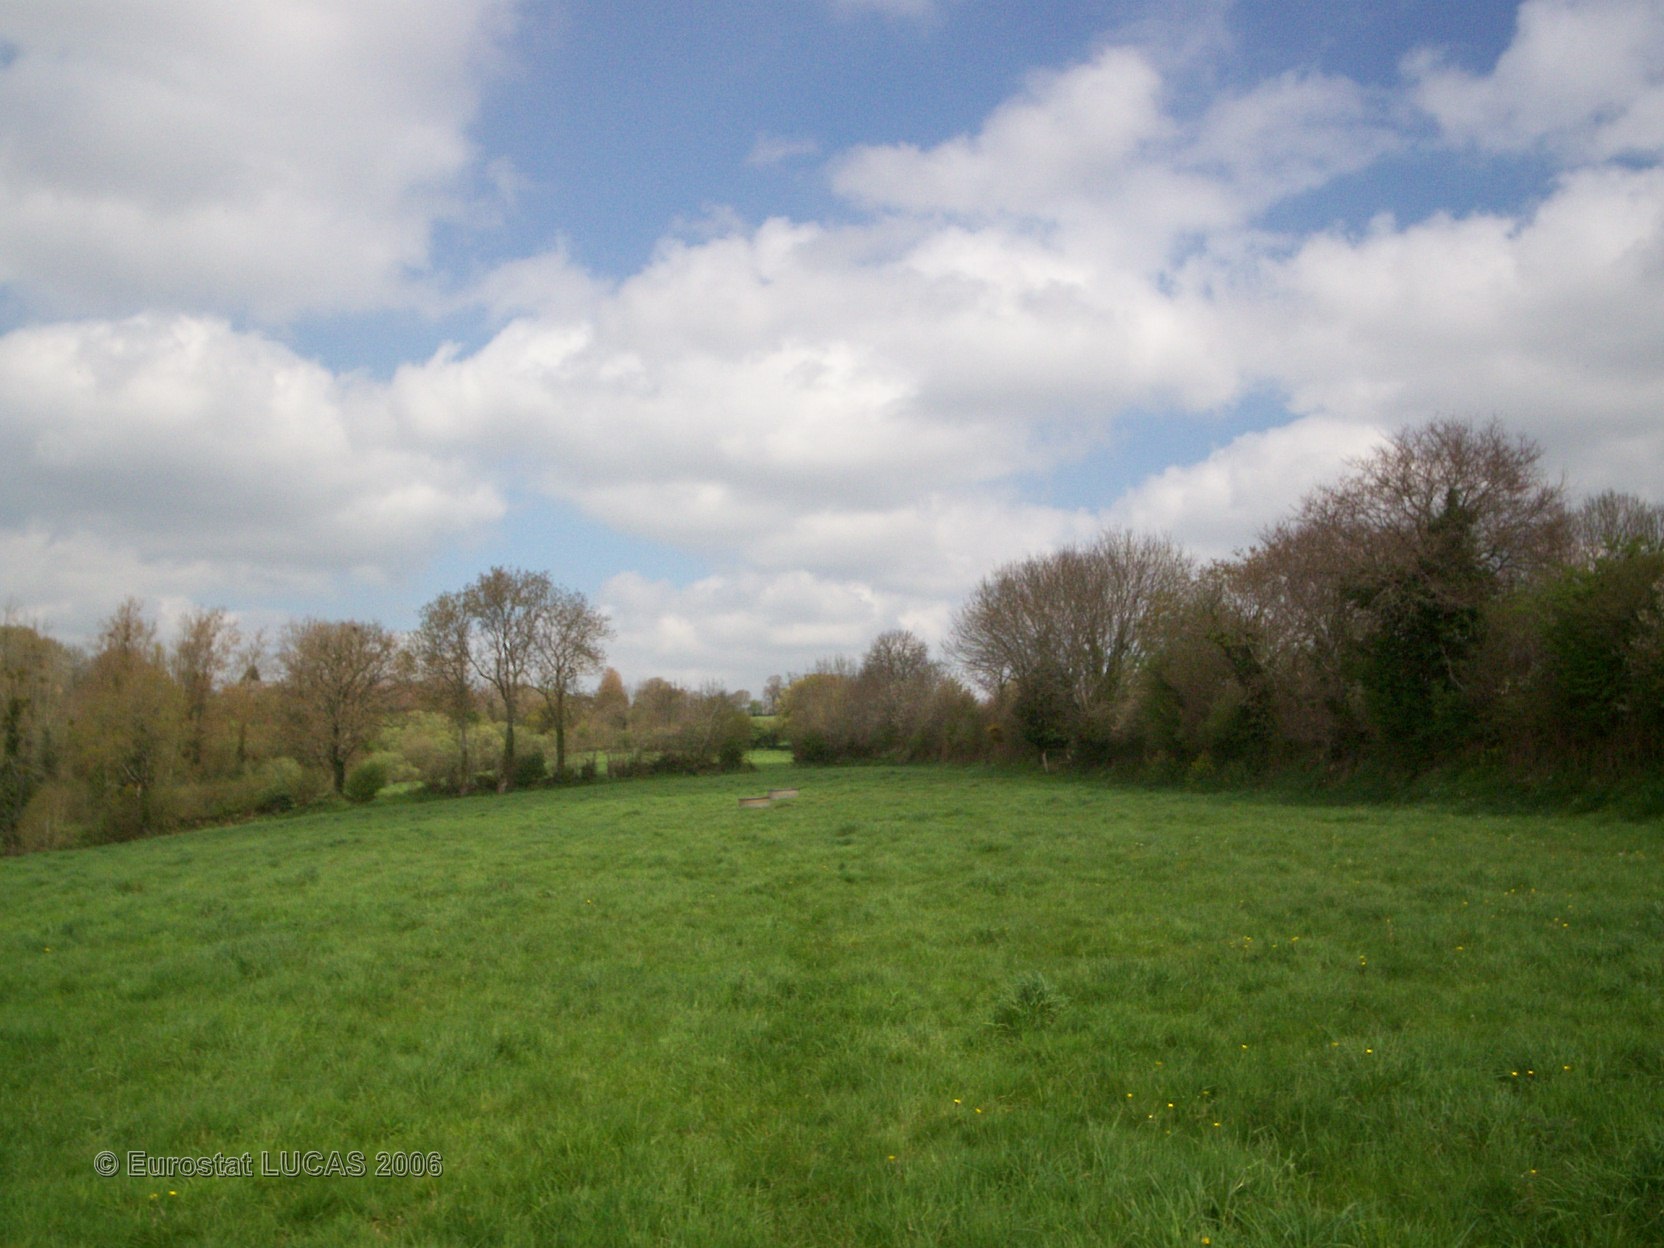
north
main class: Grassland
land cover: Grassland without tree/shrub cover
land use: Agriculture (excluding fallow land and kitchen gardens)
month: May
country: FR
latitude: 49.0455
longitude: -1.4166
